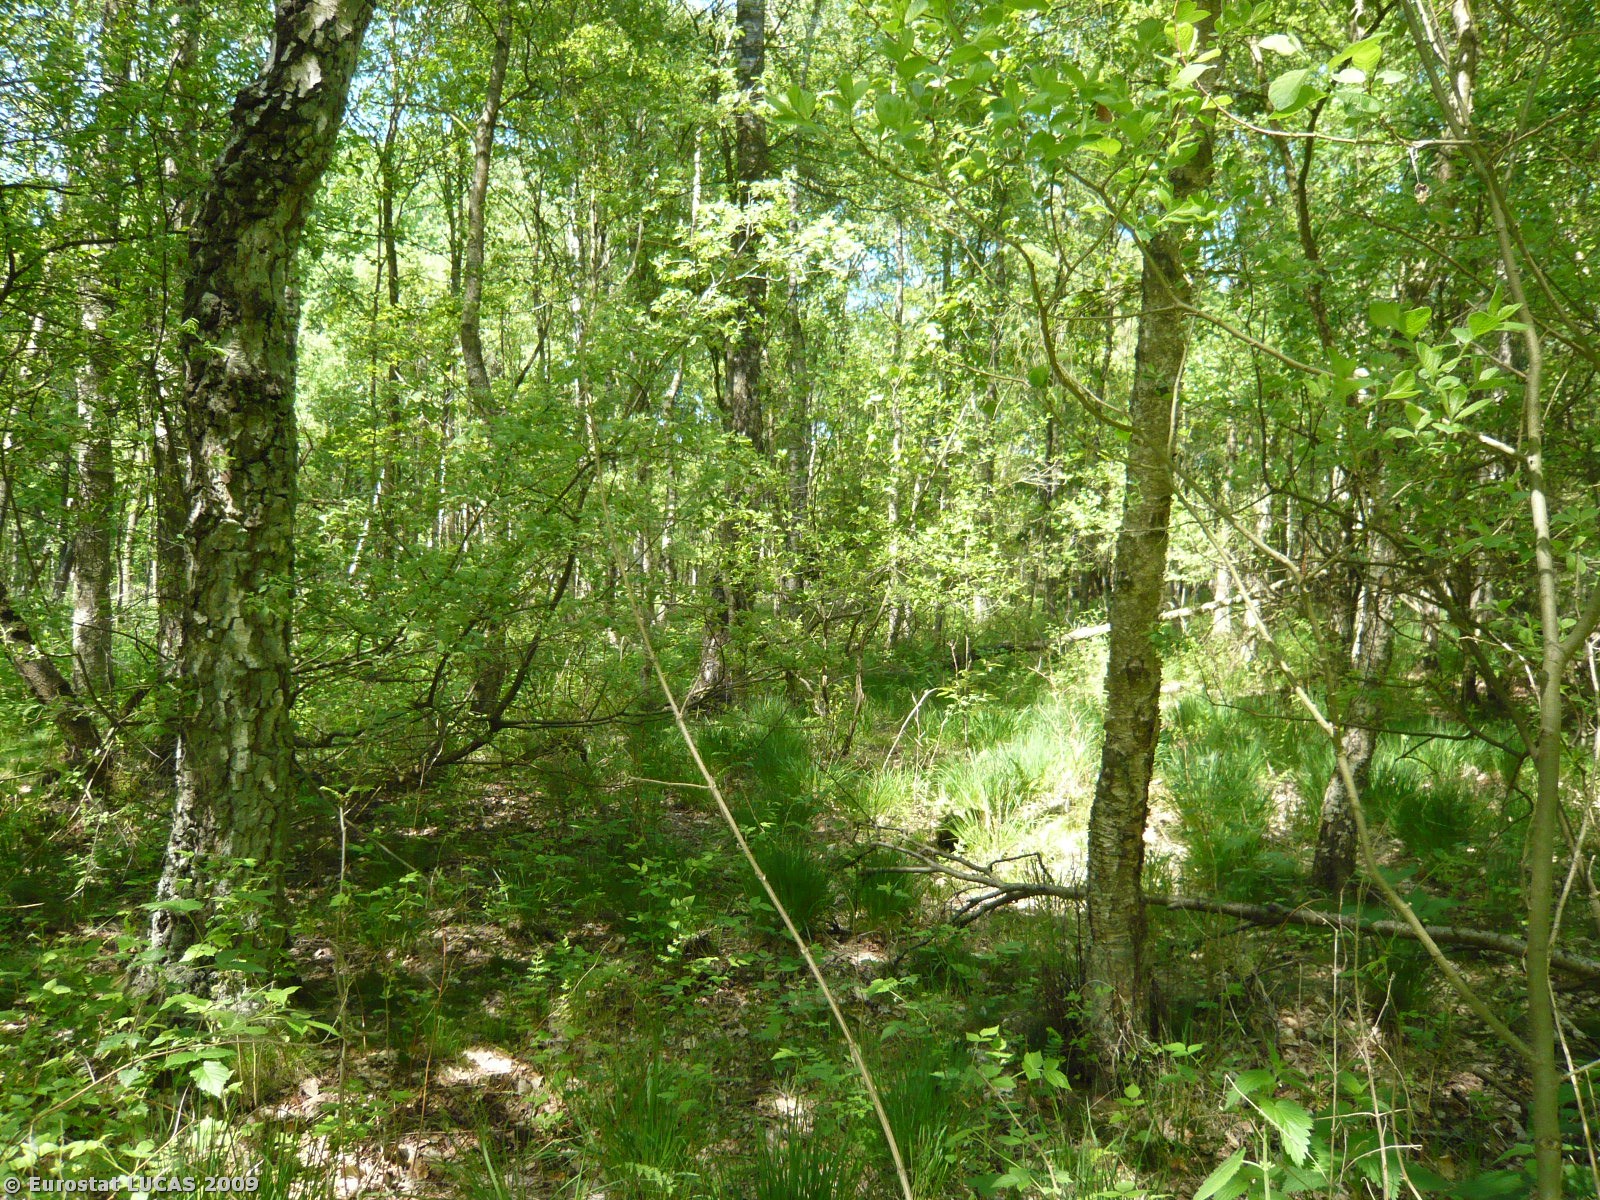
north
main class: Woodland
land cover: Broadleaved woodland
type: non-riverine alder, birch or aspen forest
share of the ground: > 75 %
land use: Forestry
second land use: Amenities, museums, leisure
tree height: > 5 m
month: May
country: DK
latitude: 55.3124
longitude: 11.7790
